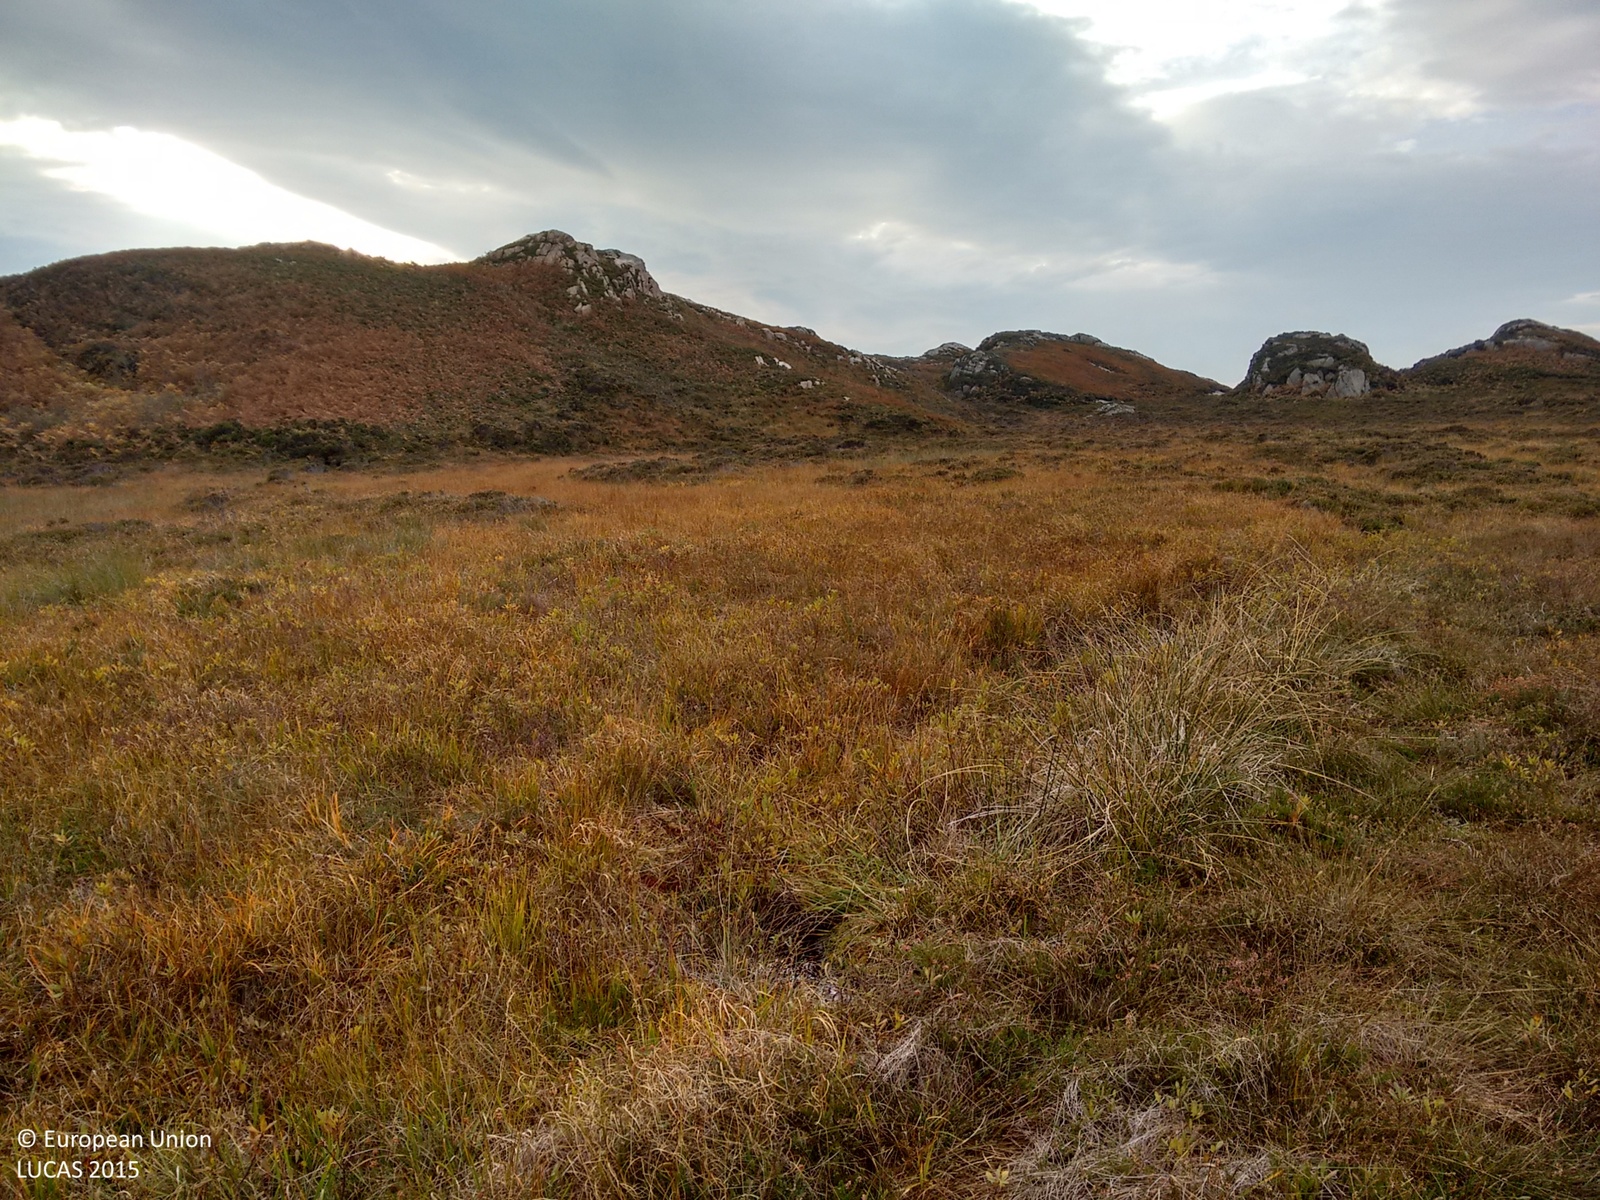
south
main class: Shrubland
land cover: Shrubland without tree cover
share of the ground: > 75 %
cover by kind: shrubs 40 %, herbaceous plants 30 %, lichens and mosses 30 %
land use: Semi-natural and natural areas not in use
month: October
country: GB
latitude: 56.3438
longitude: -6.3389
